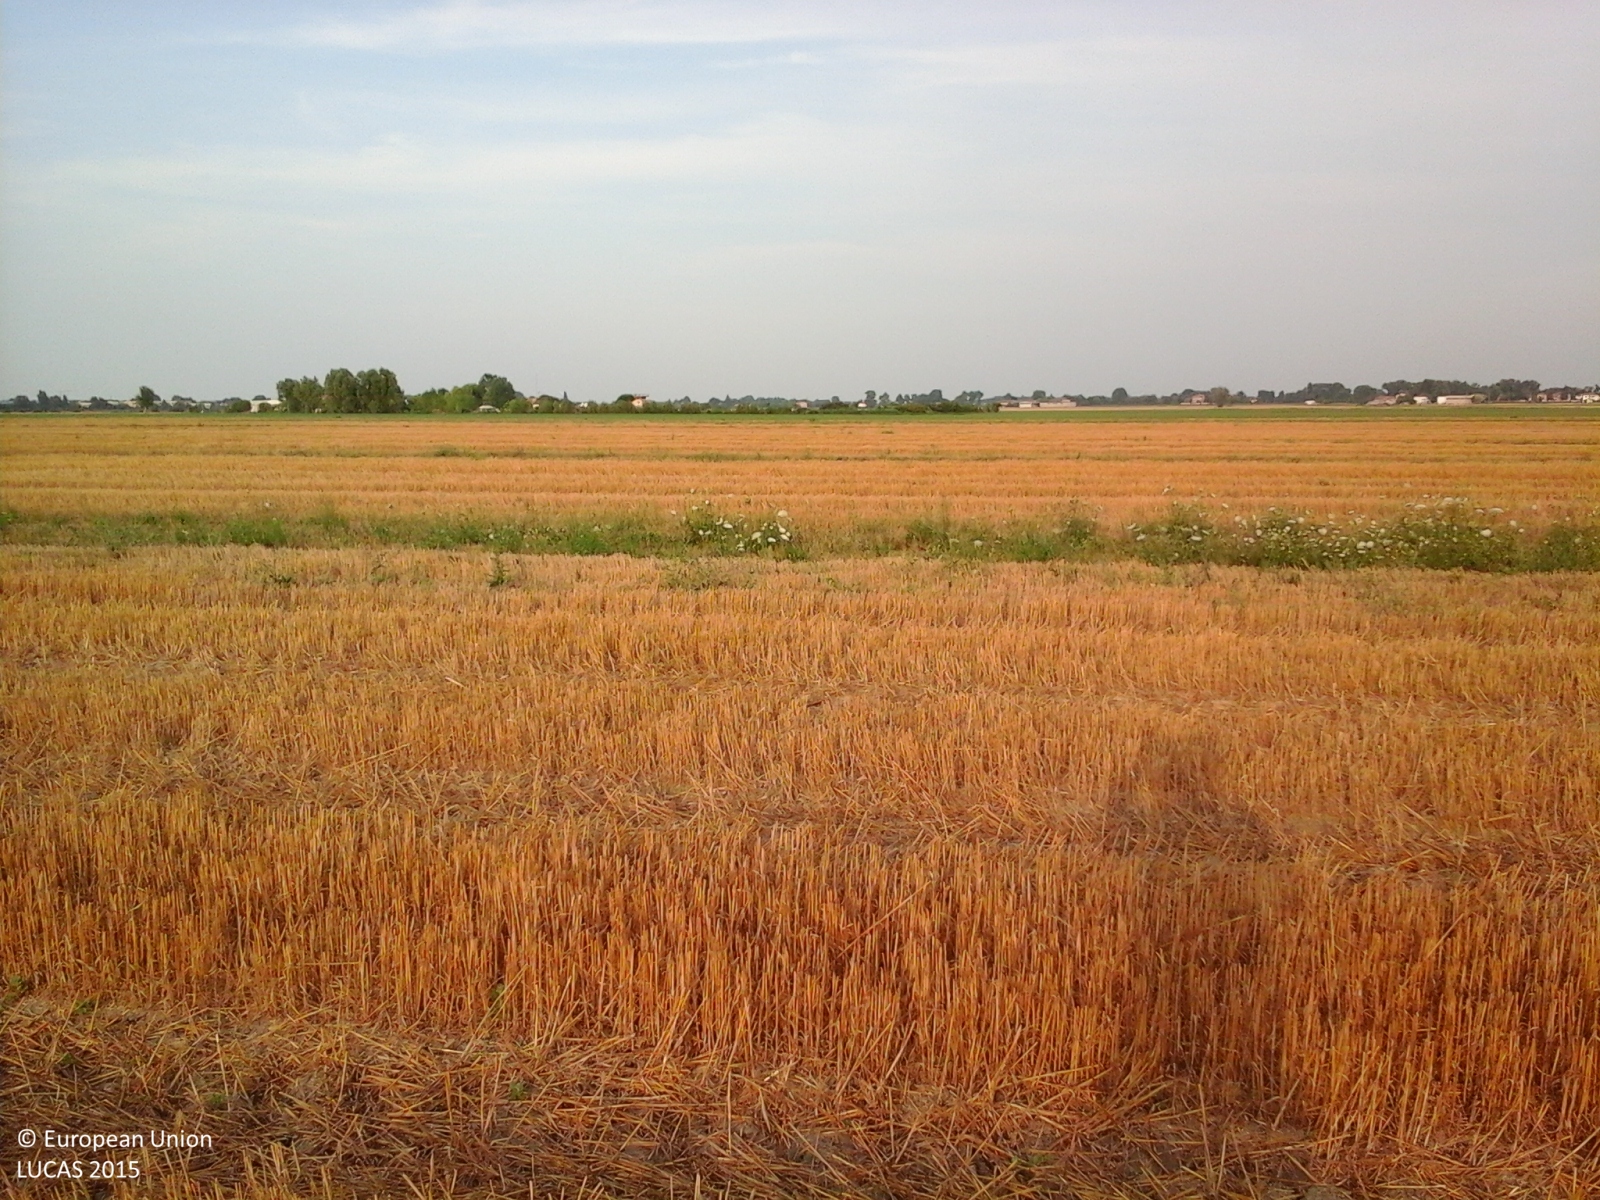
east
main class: Cropland
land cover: Common wheat
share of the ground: > 75 %
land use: Agriculture (excluding fallow land and kitchen gardens)
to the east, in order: Common wheat; Ditches and canals; Common wheat; Ditches and canals; Common wheat; Ditches and canals; Common wheat; Ditches and canals; Common wheat; Ditches and canals; Common wheat; Ditches and canals; Common wheat; Ditches and canals; Common wheat; Ditches and canals; Common wheat; Ditches and canals; Common wheat
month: July
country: IT
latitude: 44.8071
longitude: 11.6025
